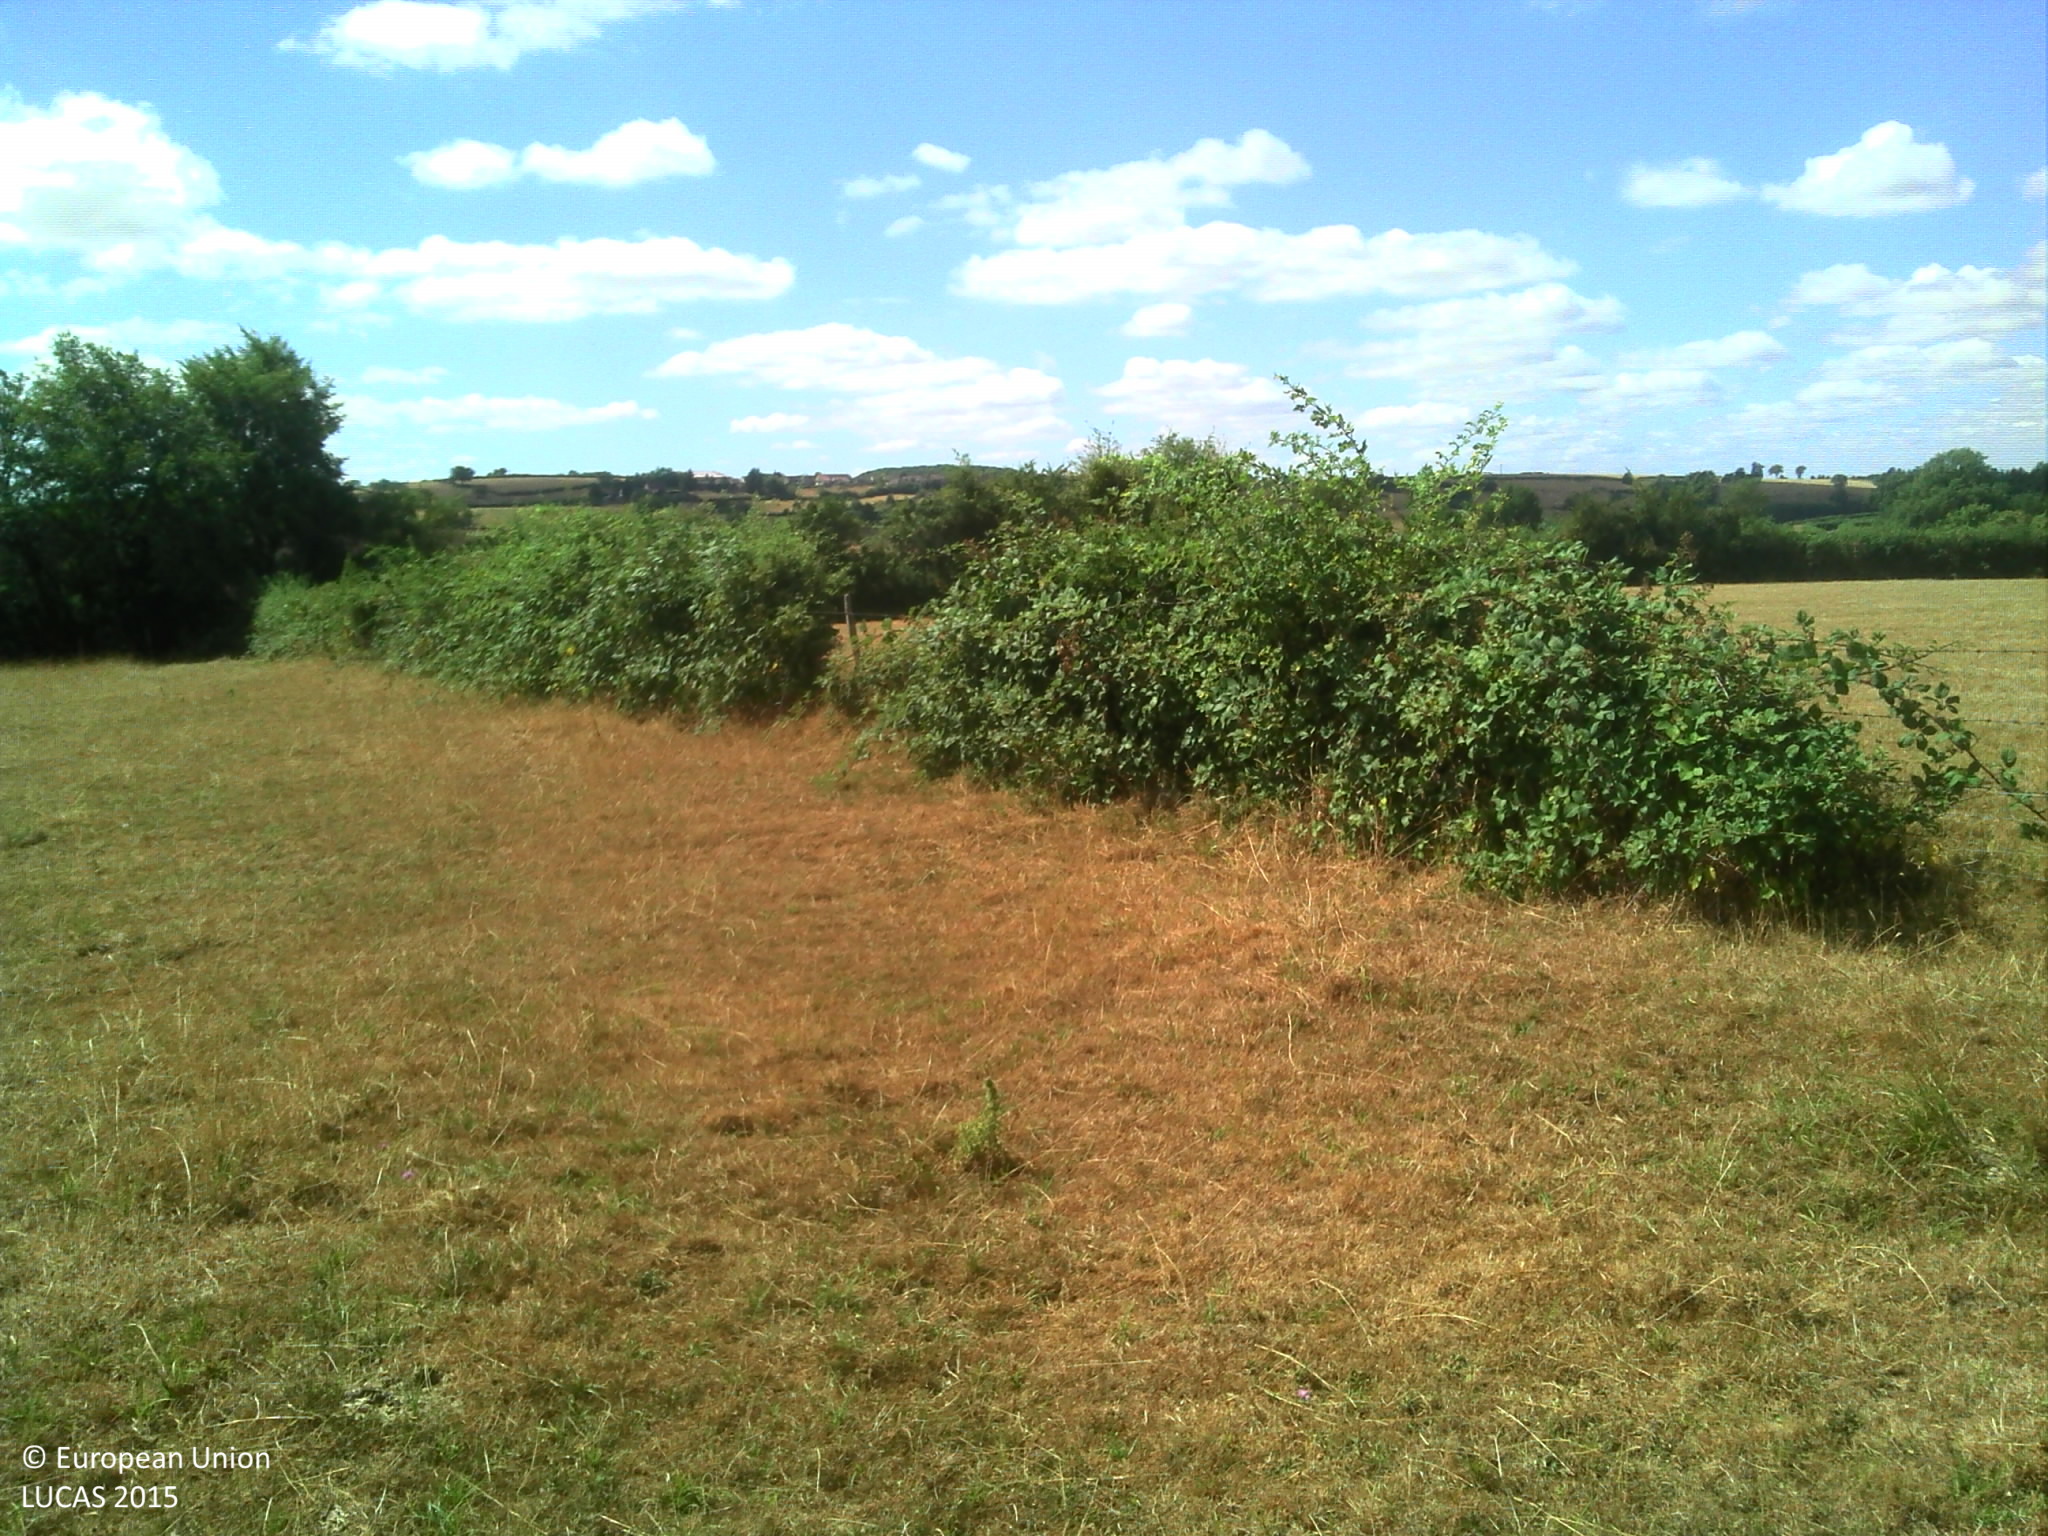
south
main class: Grassland
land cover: Grassland without tree/shrub cover
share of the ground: > 75 %
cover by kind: herbaceous plants 100 %
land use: Agriculture (excluding fallow land and kitchen gardens)
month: July
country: FR
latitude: 46.8418
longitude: 4.5064
